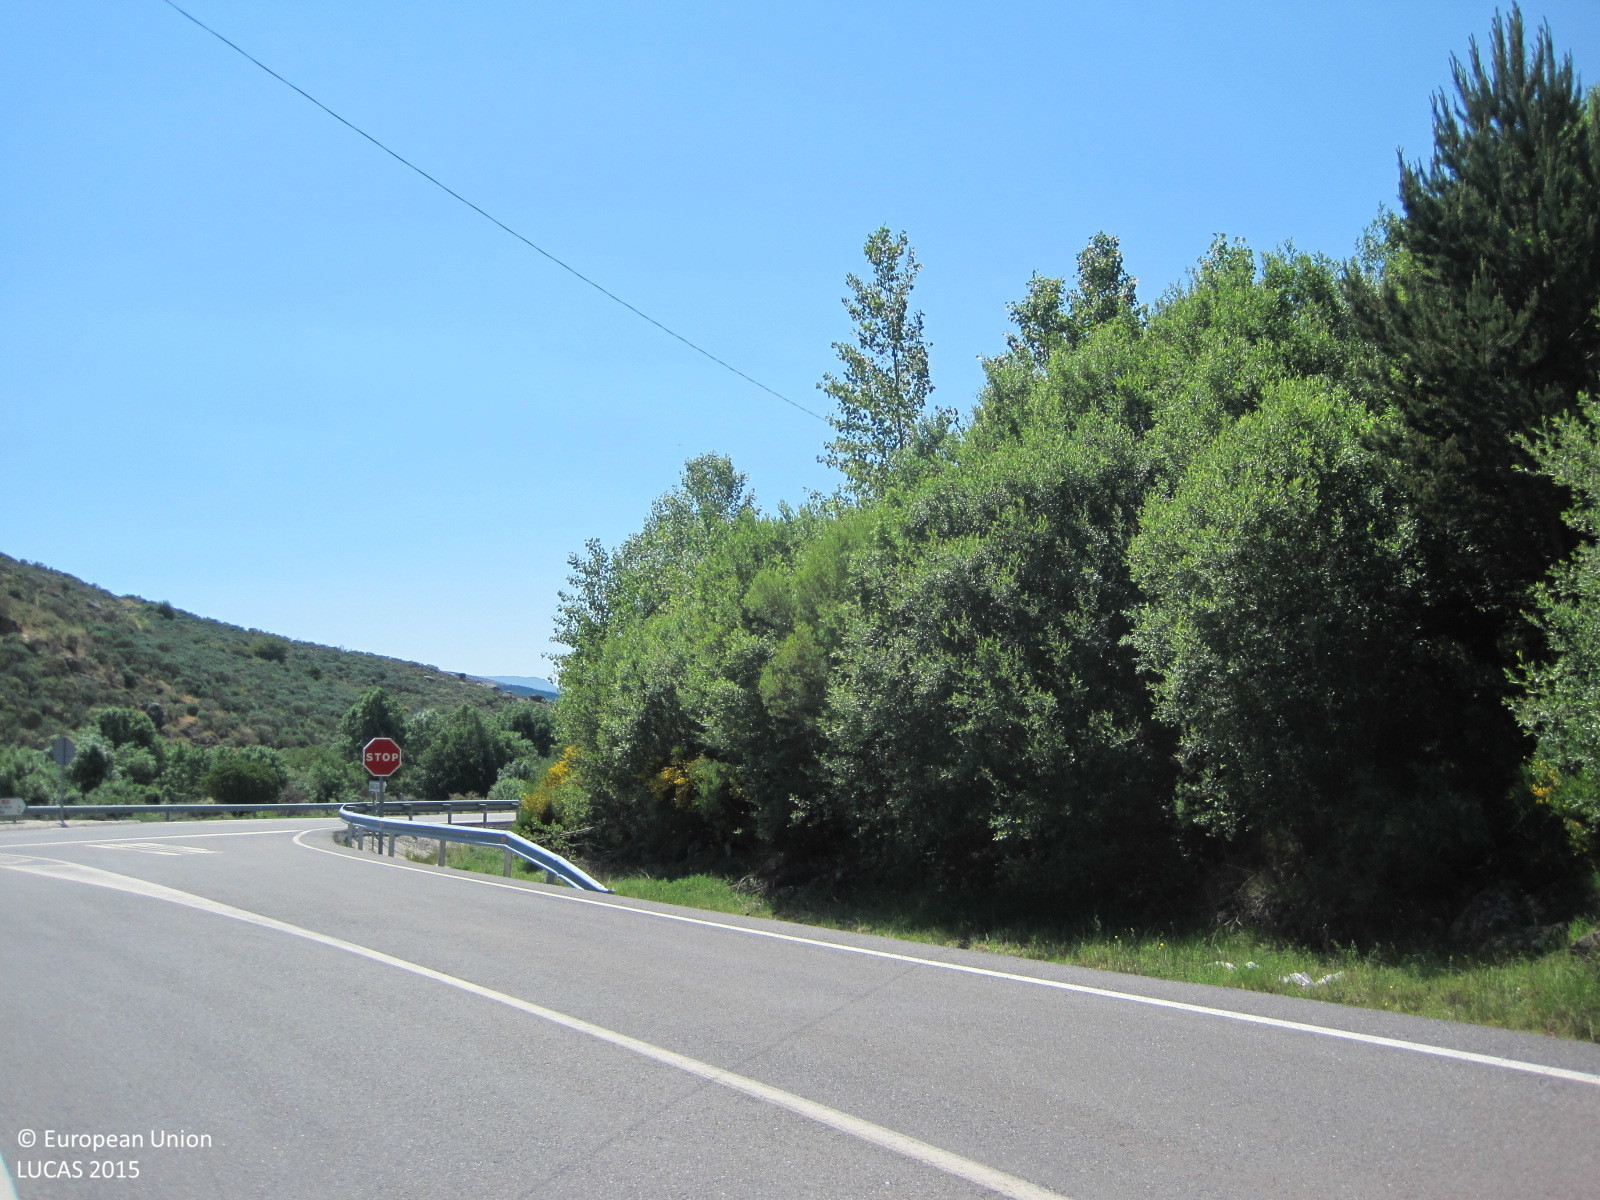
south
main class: Shrubland
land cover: Shrubland without tree cover
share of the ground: > 75 %
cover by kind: shrubs 100 %
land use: Semi-natural and natural areas not in use
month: June
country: ES
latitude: 40.4053
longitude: -5.0341
